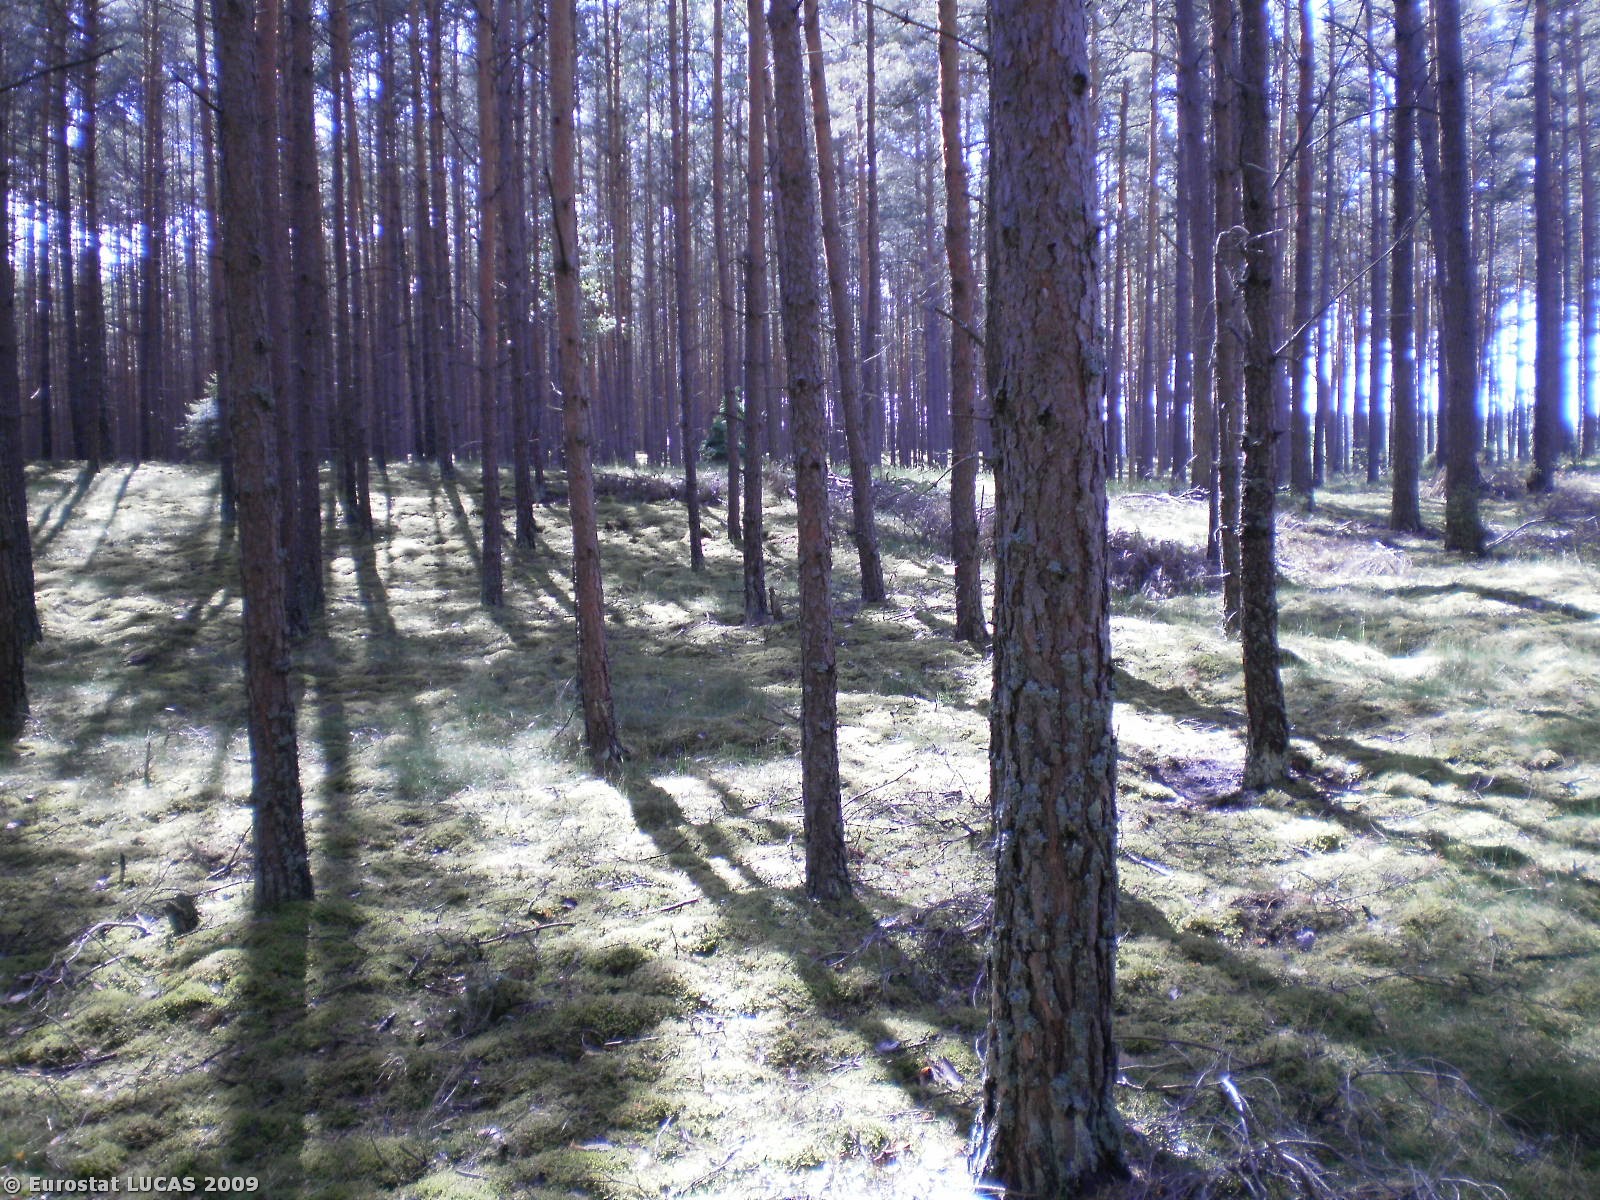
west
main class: Woodland
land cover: Coniferous woodland
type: hemiboreal forest and nemoral coniferous forest and mixed broadleaved-coniferous forest
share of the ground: > 75 %
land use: Forestry
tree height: > 5 m
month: May
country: PL
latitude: 53.7132
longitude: 18.0299
